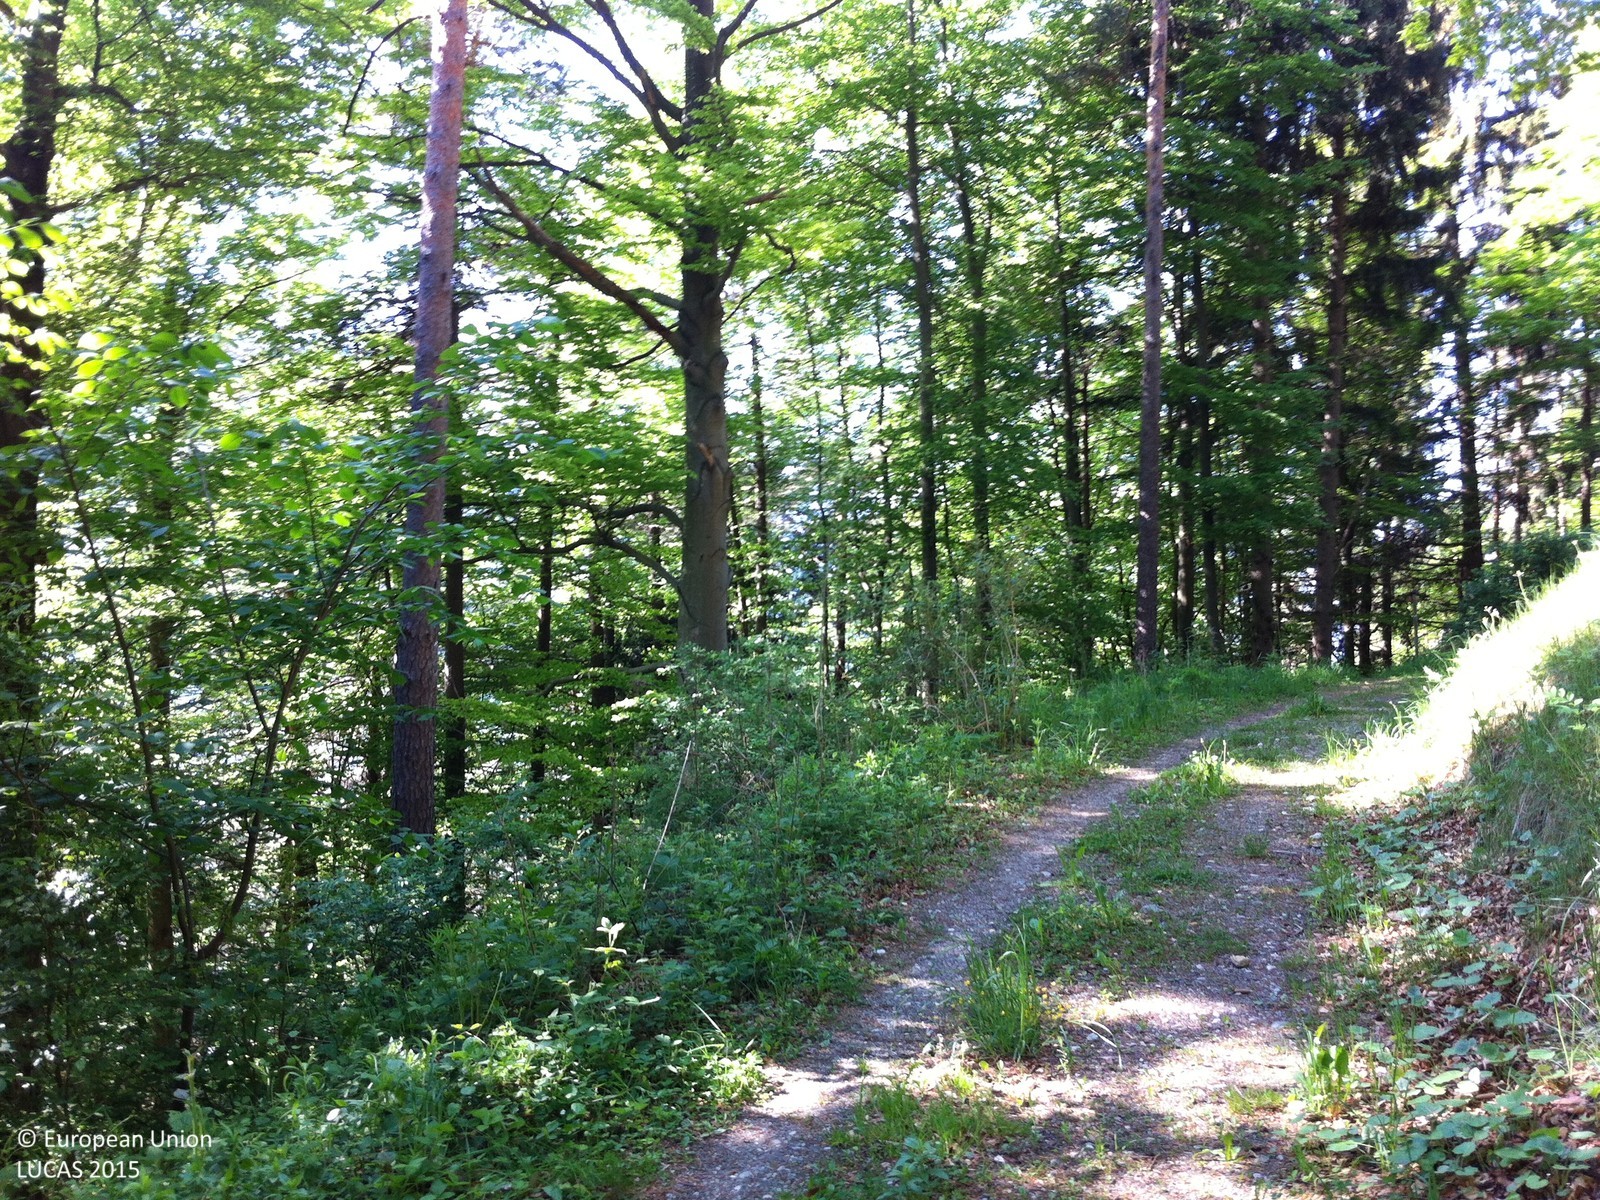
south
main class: Grassland
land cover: Spontaneously vegetated surfaces
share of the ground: > 75 %
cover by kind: herbaceous plants 70 %, unconsolidated bare surface 30 %
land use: Forestry
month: May
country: AT
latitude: 47.3642
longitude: 11.7067
